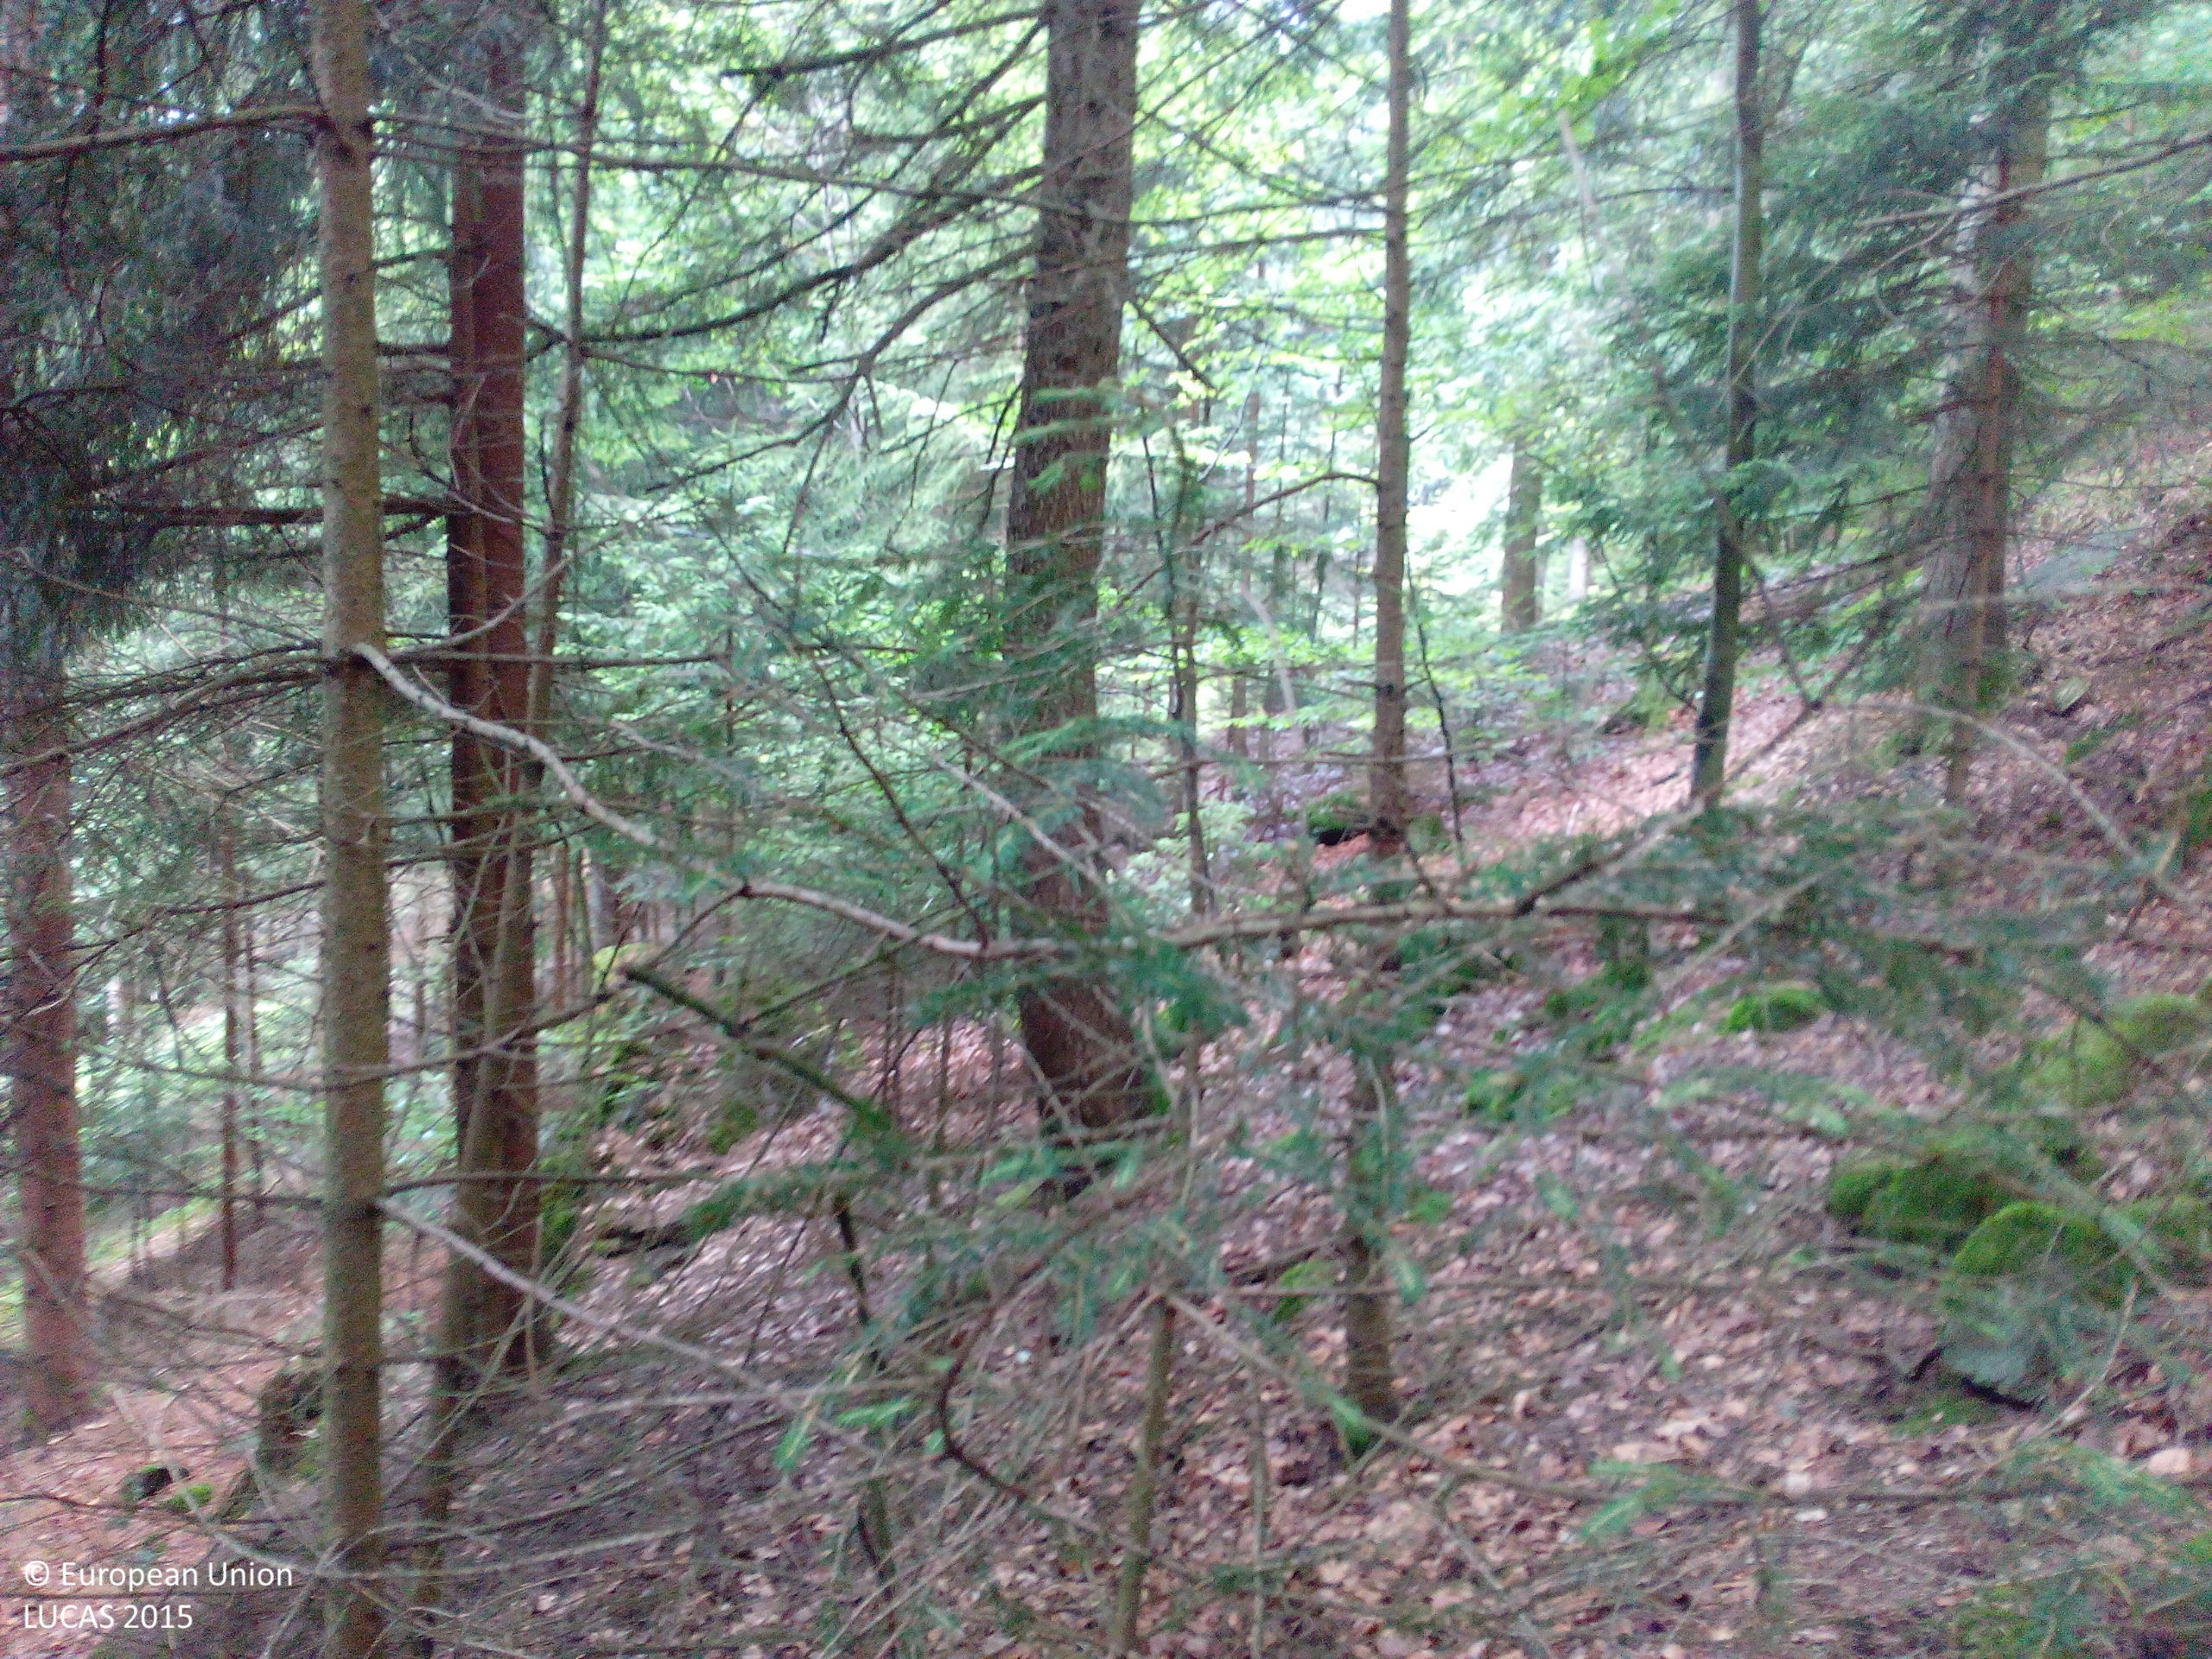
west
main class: Woodland
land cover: Spruce dominated mixed woodland
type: hemiboreal forest and nemoral coniferous forest and mixed broadleaved-coniferous forest
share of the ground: > 75 %
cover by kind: coniferous forest trees 60 %, broadleaved forest trees 25 %, unconsolidated bare surface 10 %, lichens and mosses 5 %
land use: Forestry
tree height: > 5 m
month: July
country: DE
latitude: 49.1556
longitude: 12.9751
